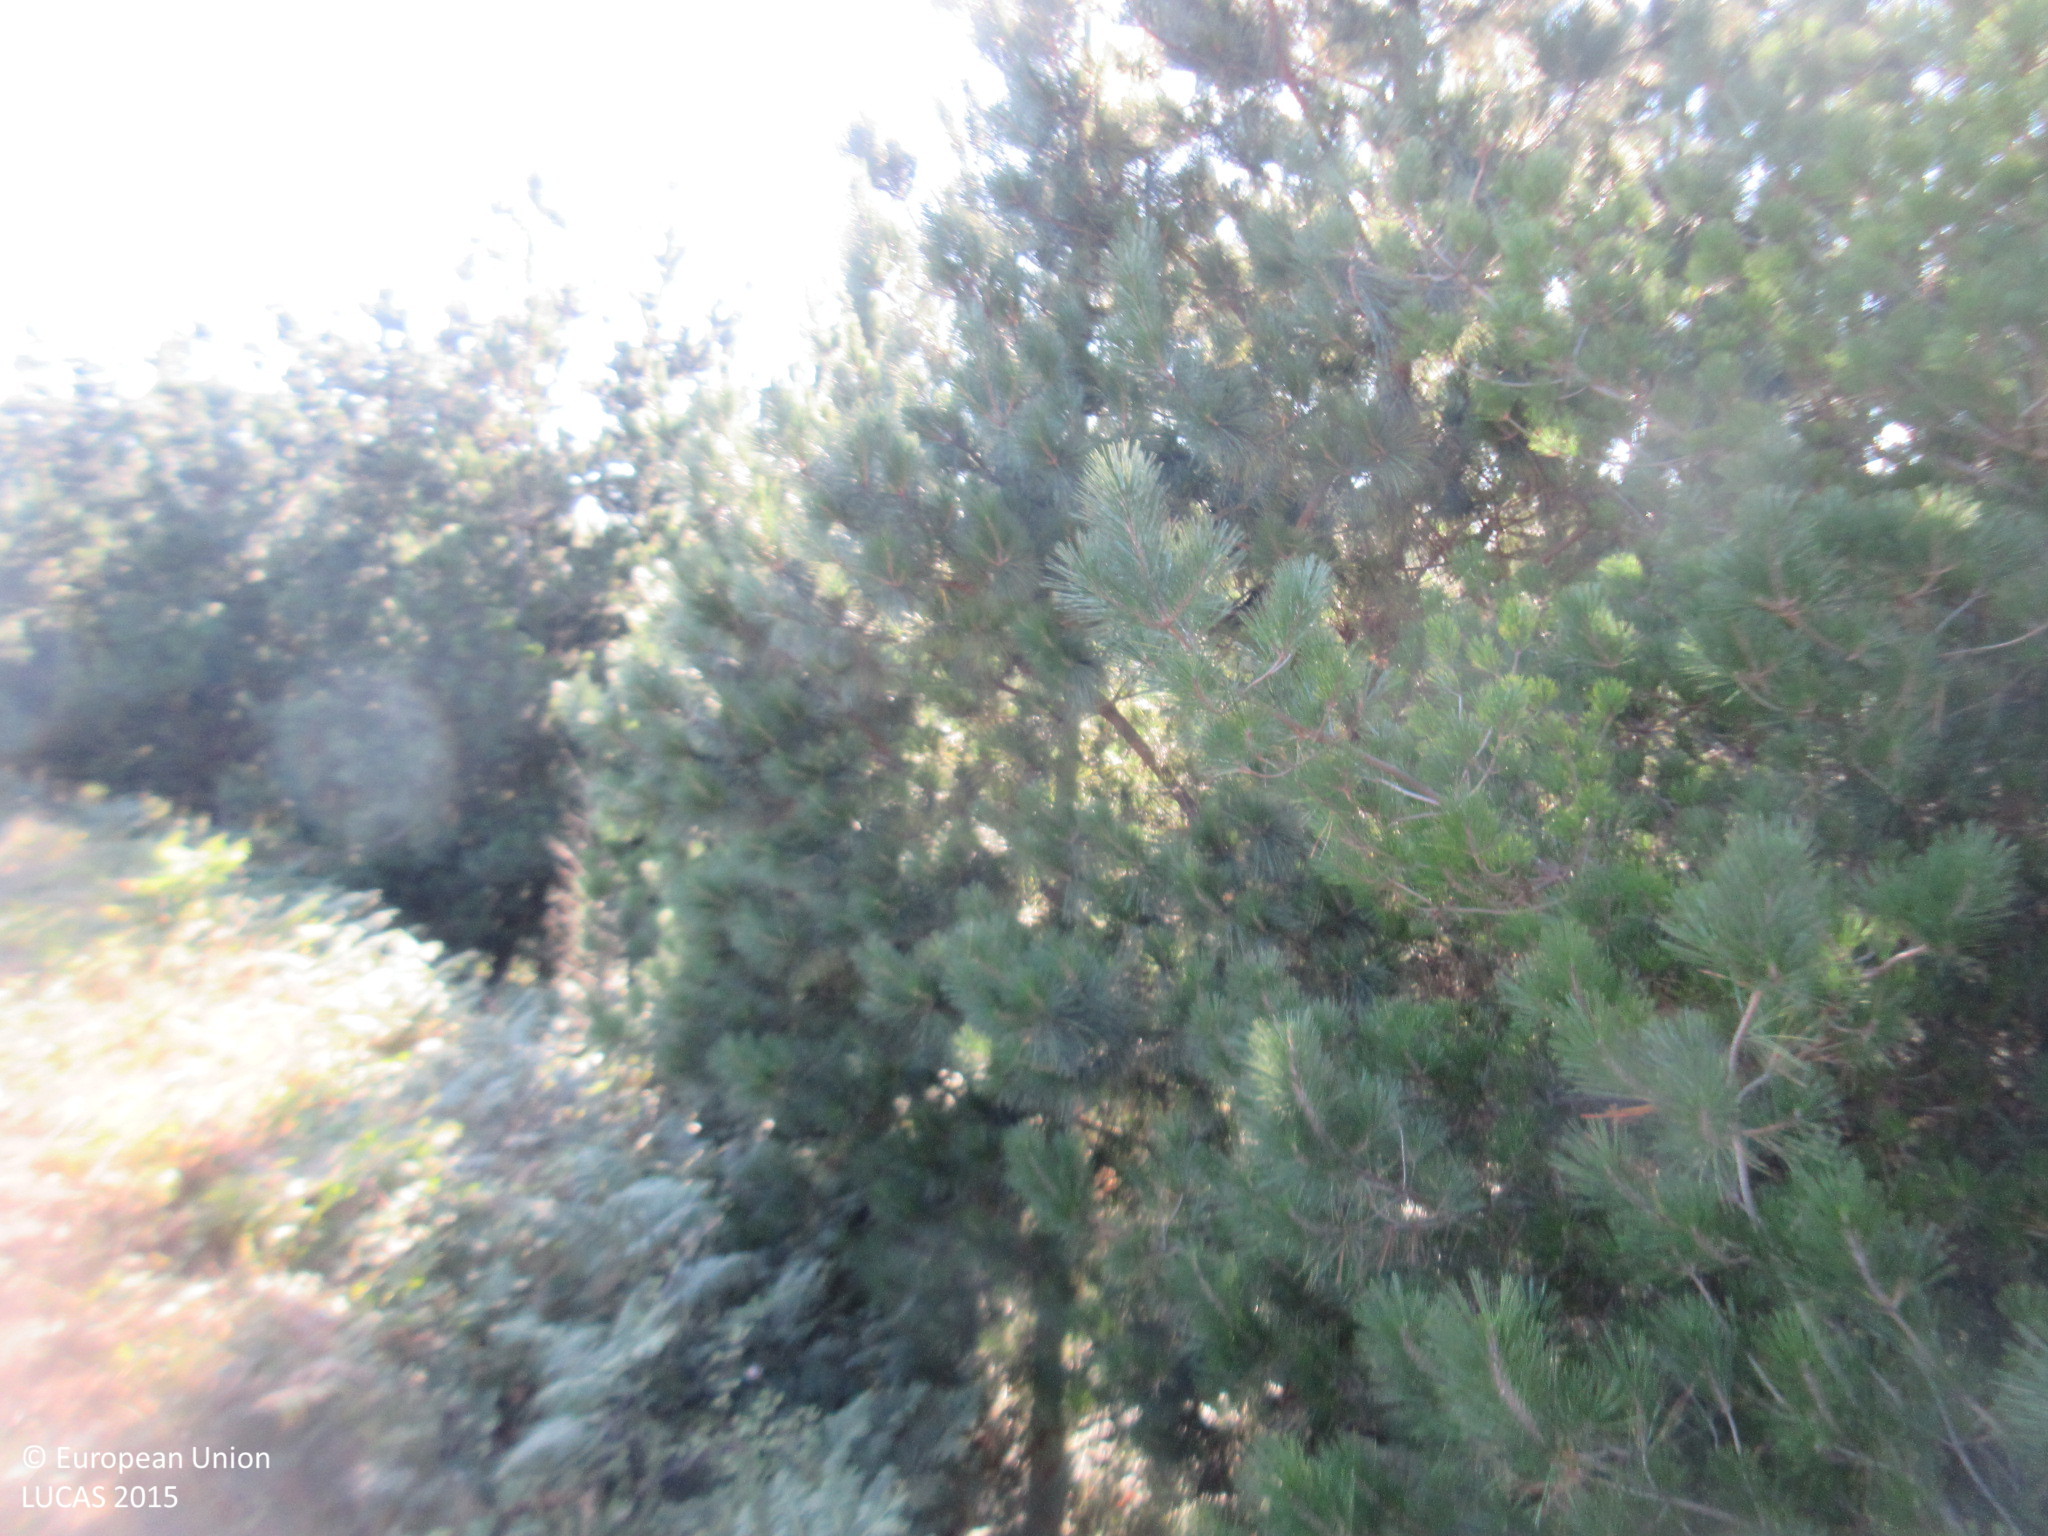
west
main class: Woodland
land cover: Pine dominated coniferous woodland
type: hemiboreal forest and nemoral coniferous forest and mixed broadleaved-coniferous forest
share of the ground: > 75 %
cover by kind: coniferous forest trees 100 %
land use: Forestry
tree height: > 5 m
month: July
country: ES
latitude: 43.1916
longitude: -3.8911
